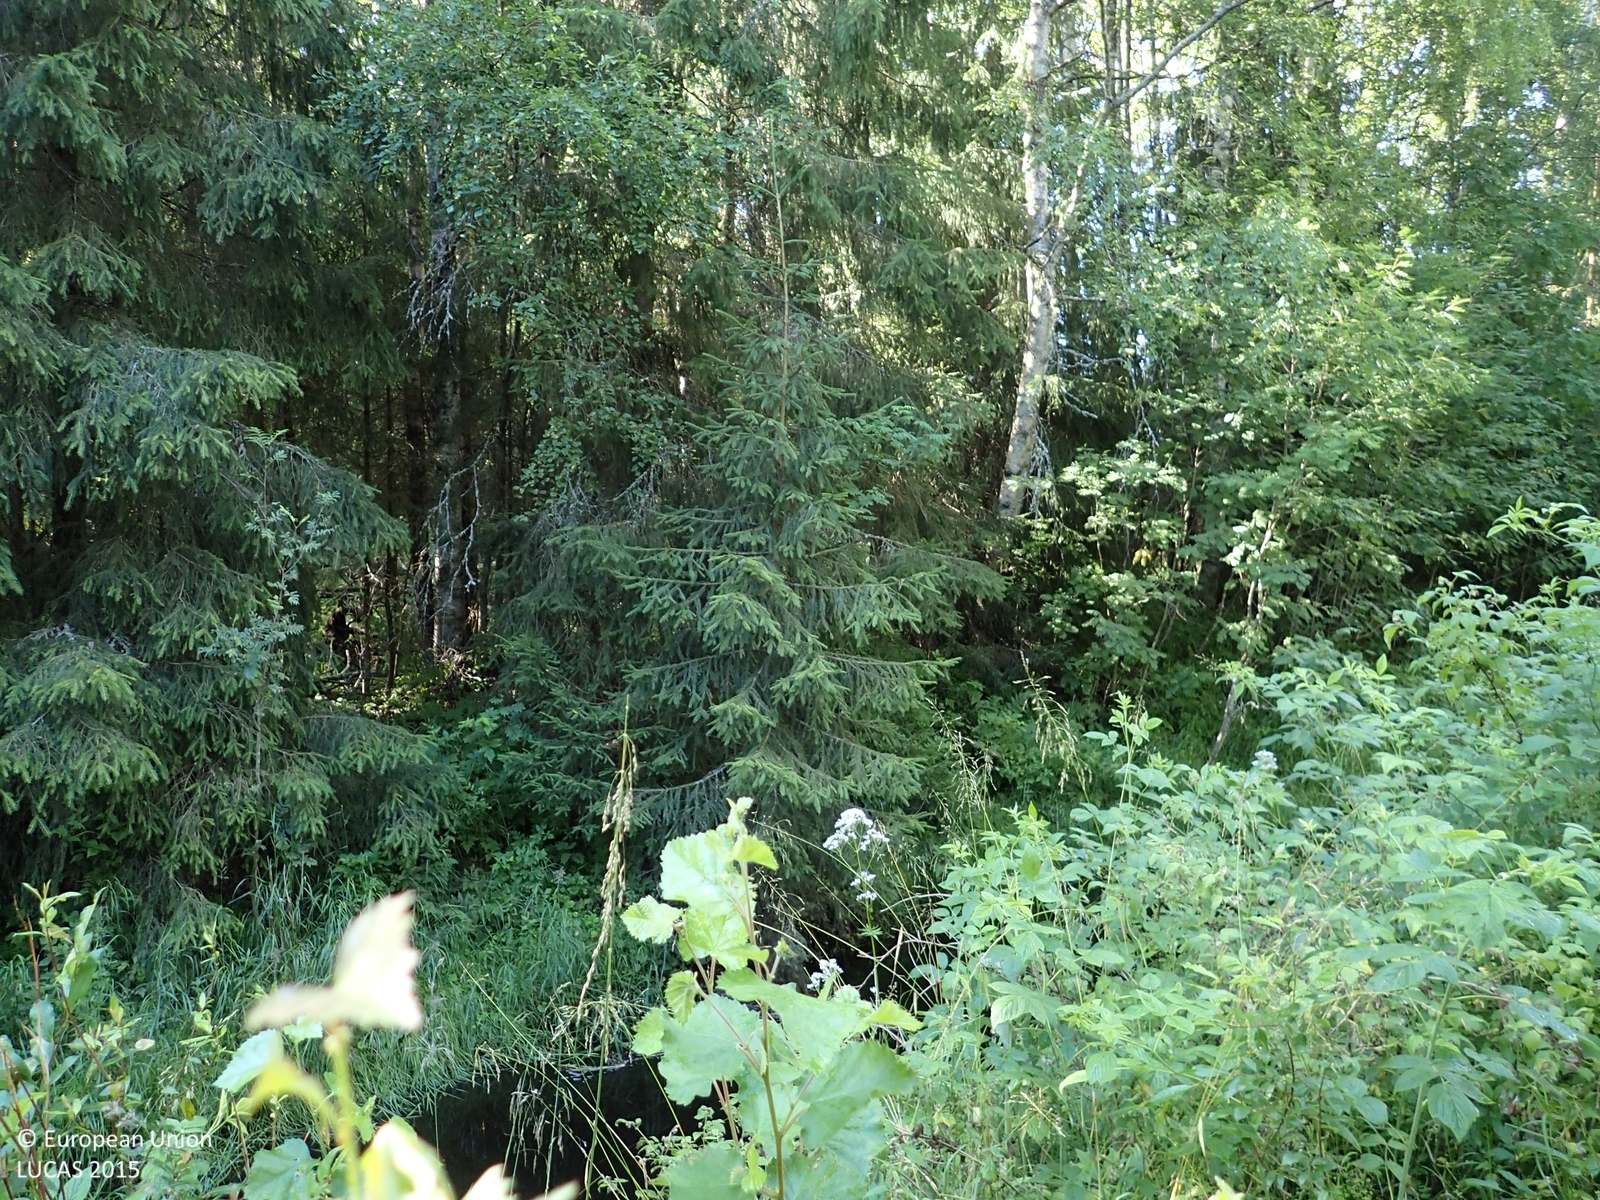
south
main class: Woodland
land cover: Broadleaved woodland
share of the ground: 25 - 50 %
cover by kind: herbaceous plants 75 %, broadleaved forest trees 25 %
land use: Forestry
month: August
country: FI
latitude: 62.9676
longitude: 21.8172
